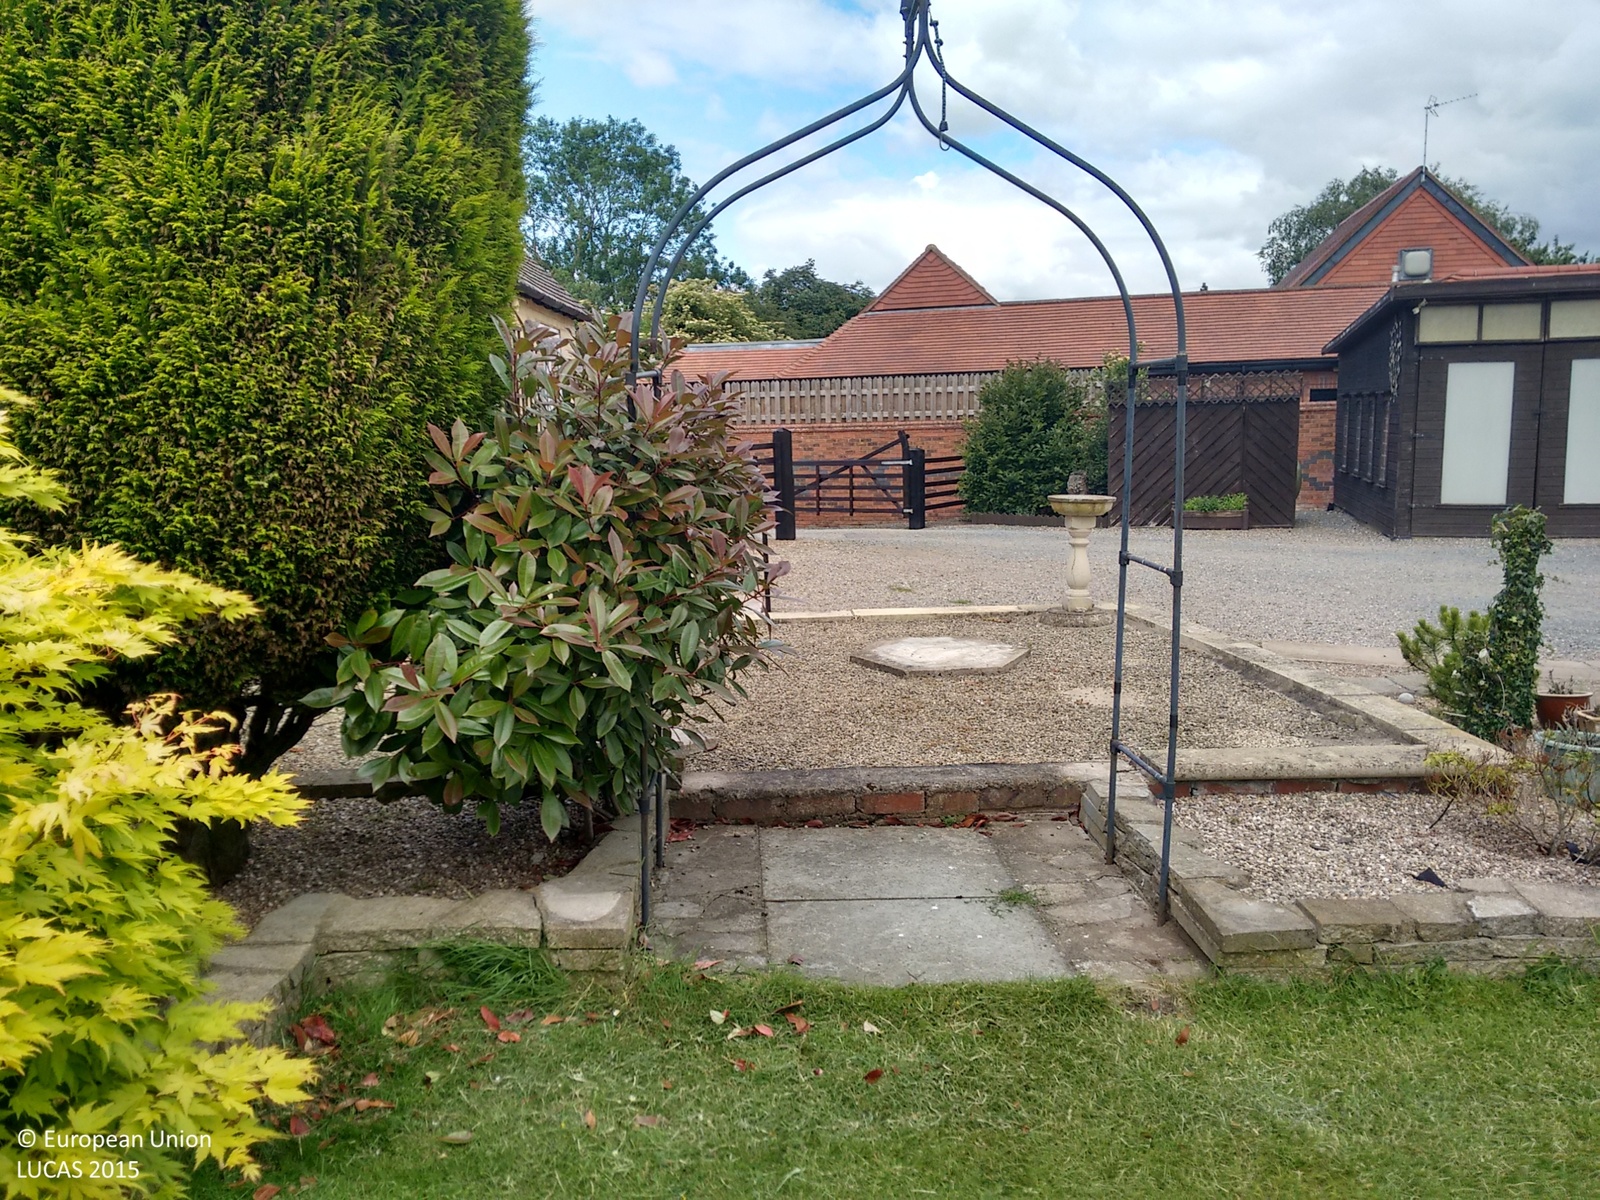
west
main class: Grassland
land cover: Grassland with sparse tree/shrub cover
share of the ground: > 75 %
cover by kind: herbaceous plants 90 %, broadleaved forest trees 5 %, shrubs 5 %
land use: Residential
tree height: < 5 m
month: June
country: GB
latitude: 52.2394
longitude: -2.1718
